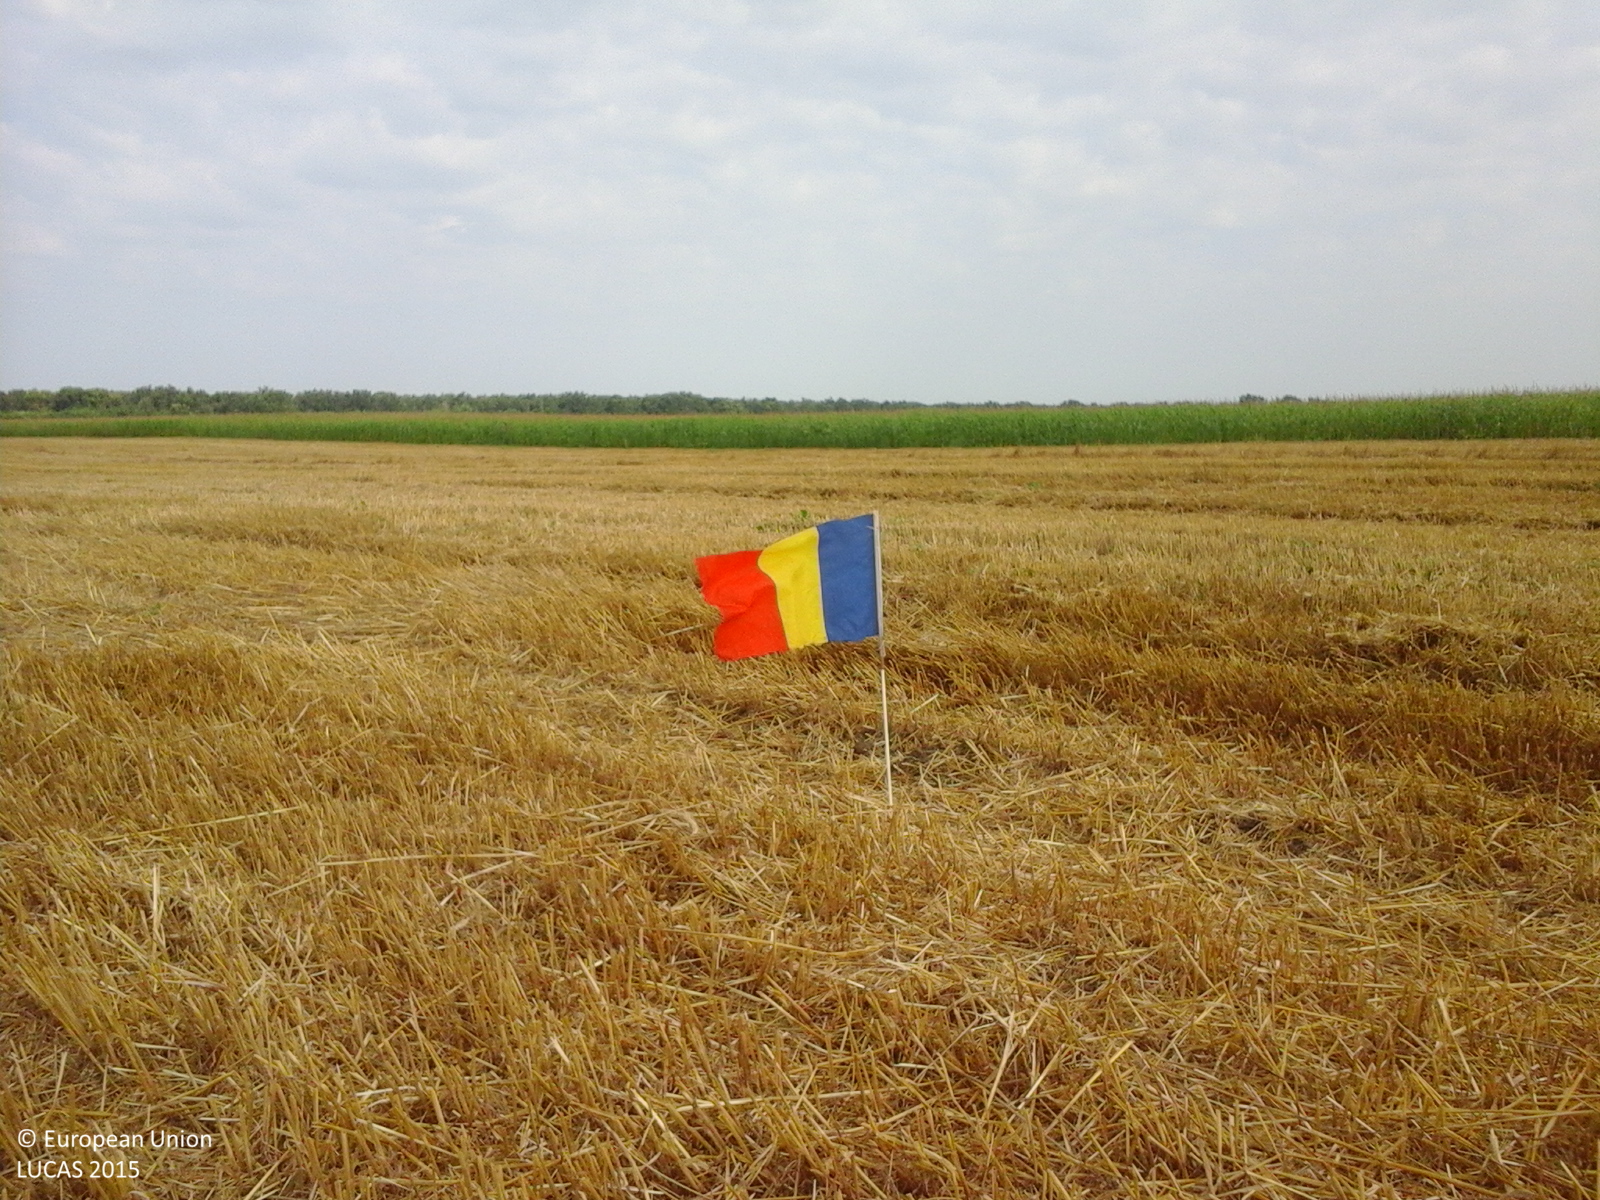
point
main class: Cropland
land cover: Durum wheat
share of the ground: < 10 %
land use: Agriculture (excluding fallow land and kitchen gardens)
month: July
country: RO
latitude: 44.5811
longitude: 26.8382
